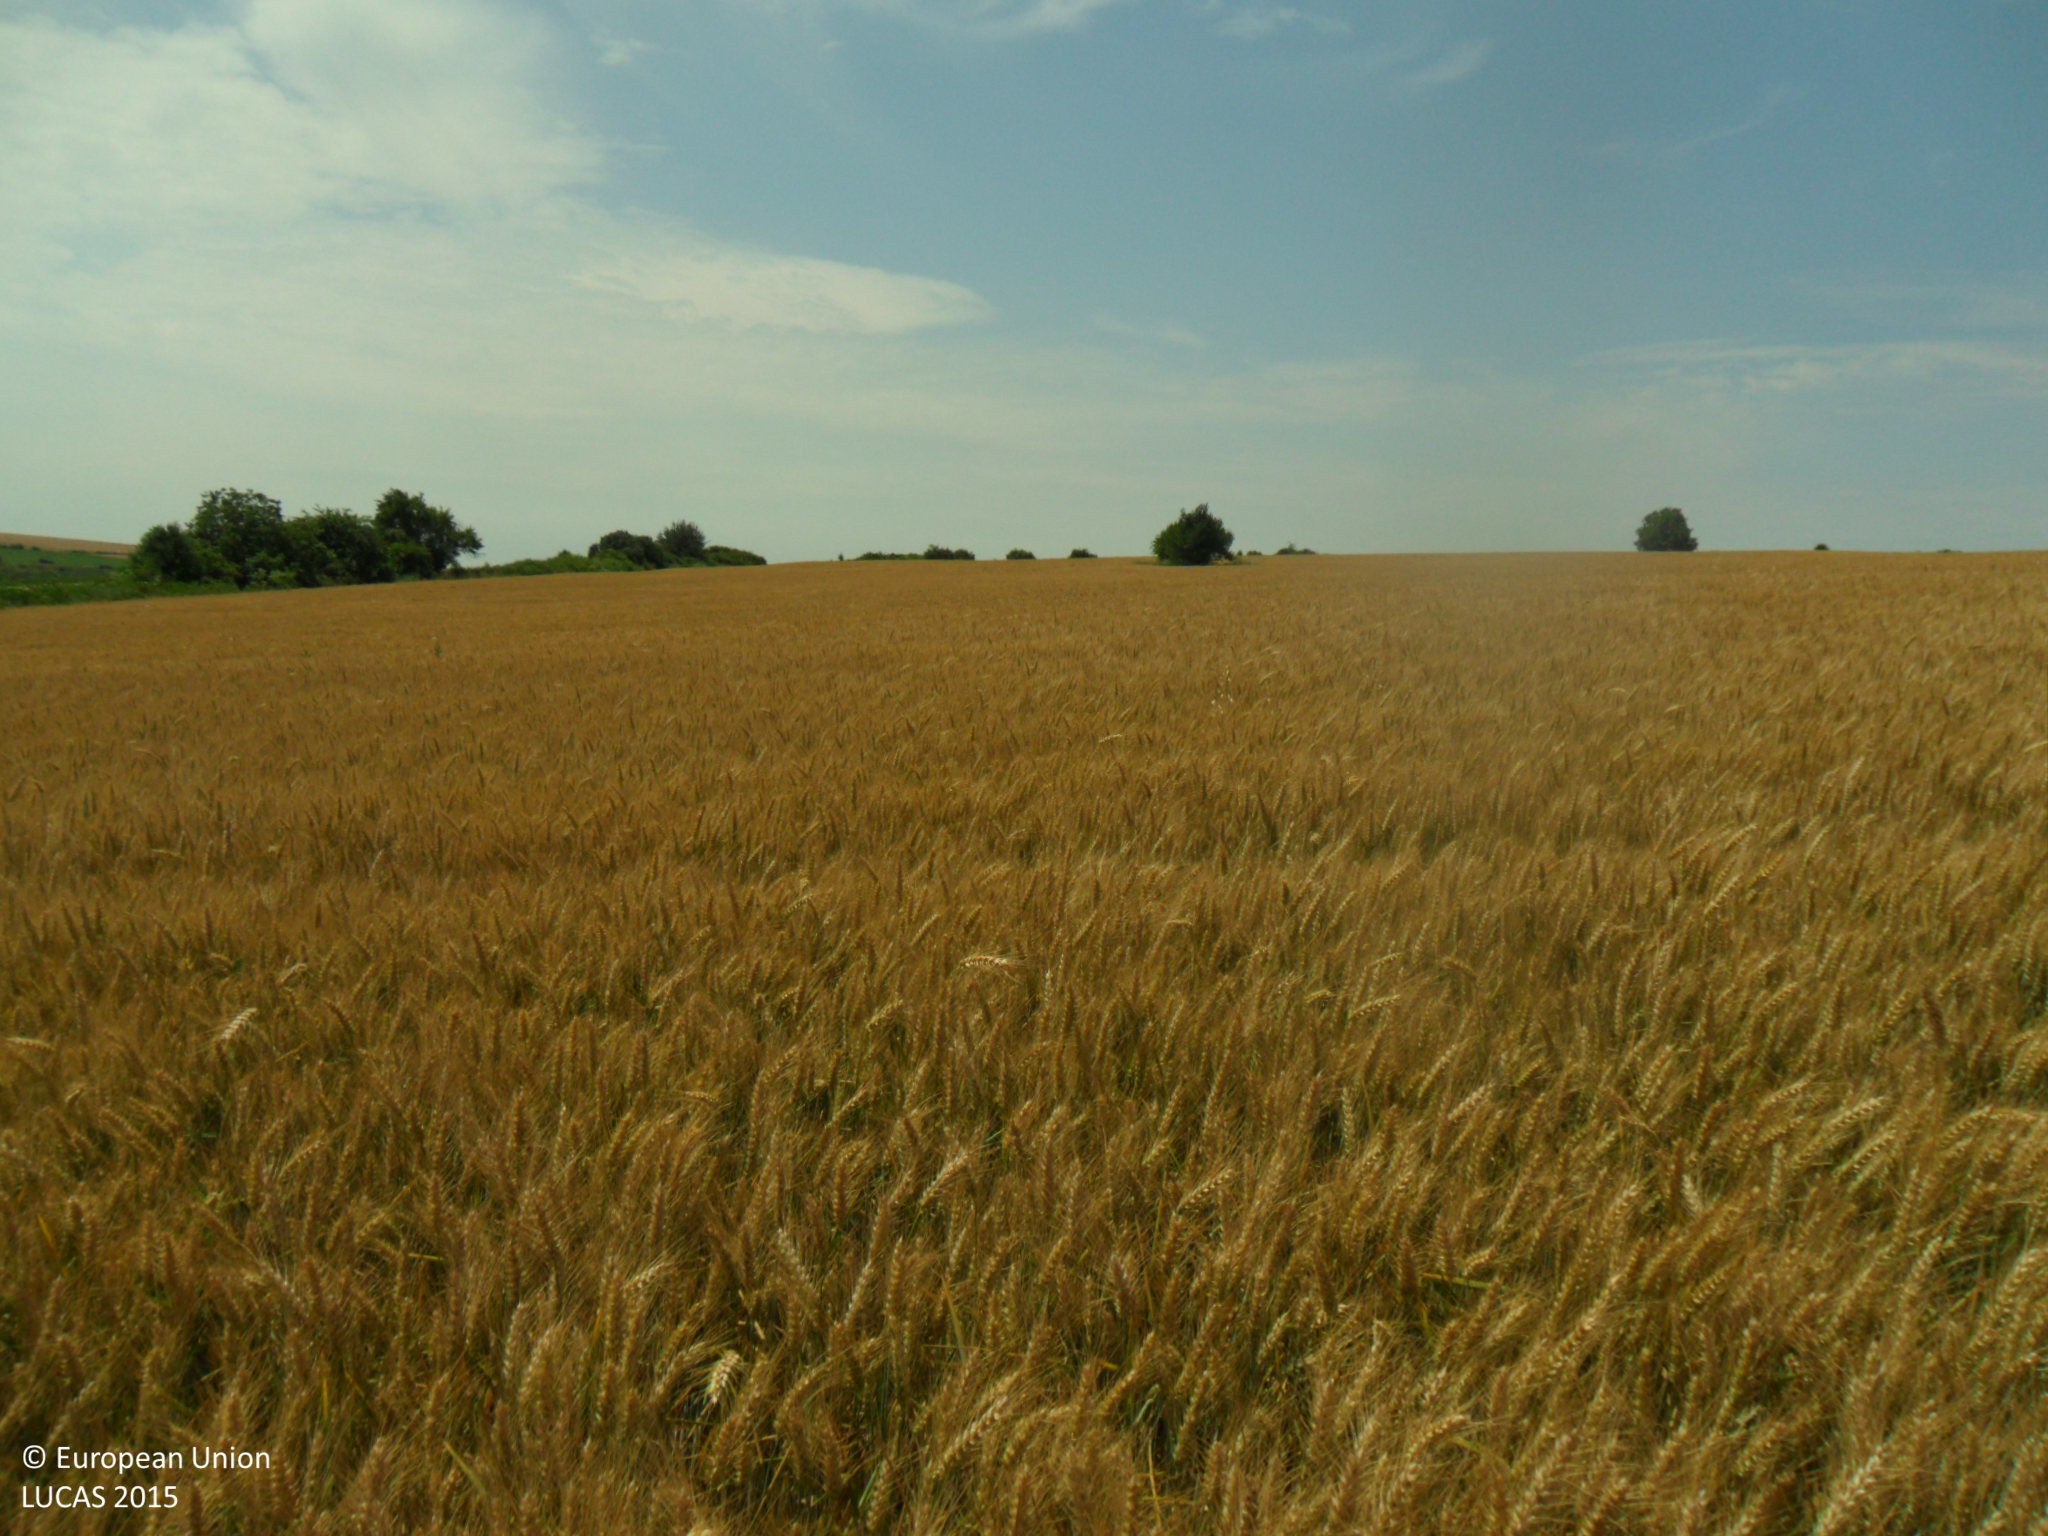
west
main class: Cropland
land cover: Common wheat
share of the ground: > 75 %
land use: Agriculture (excluding fallow land and kitchen gardens)
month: June
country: BG
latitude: 43.3789
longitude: 26.9883
